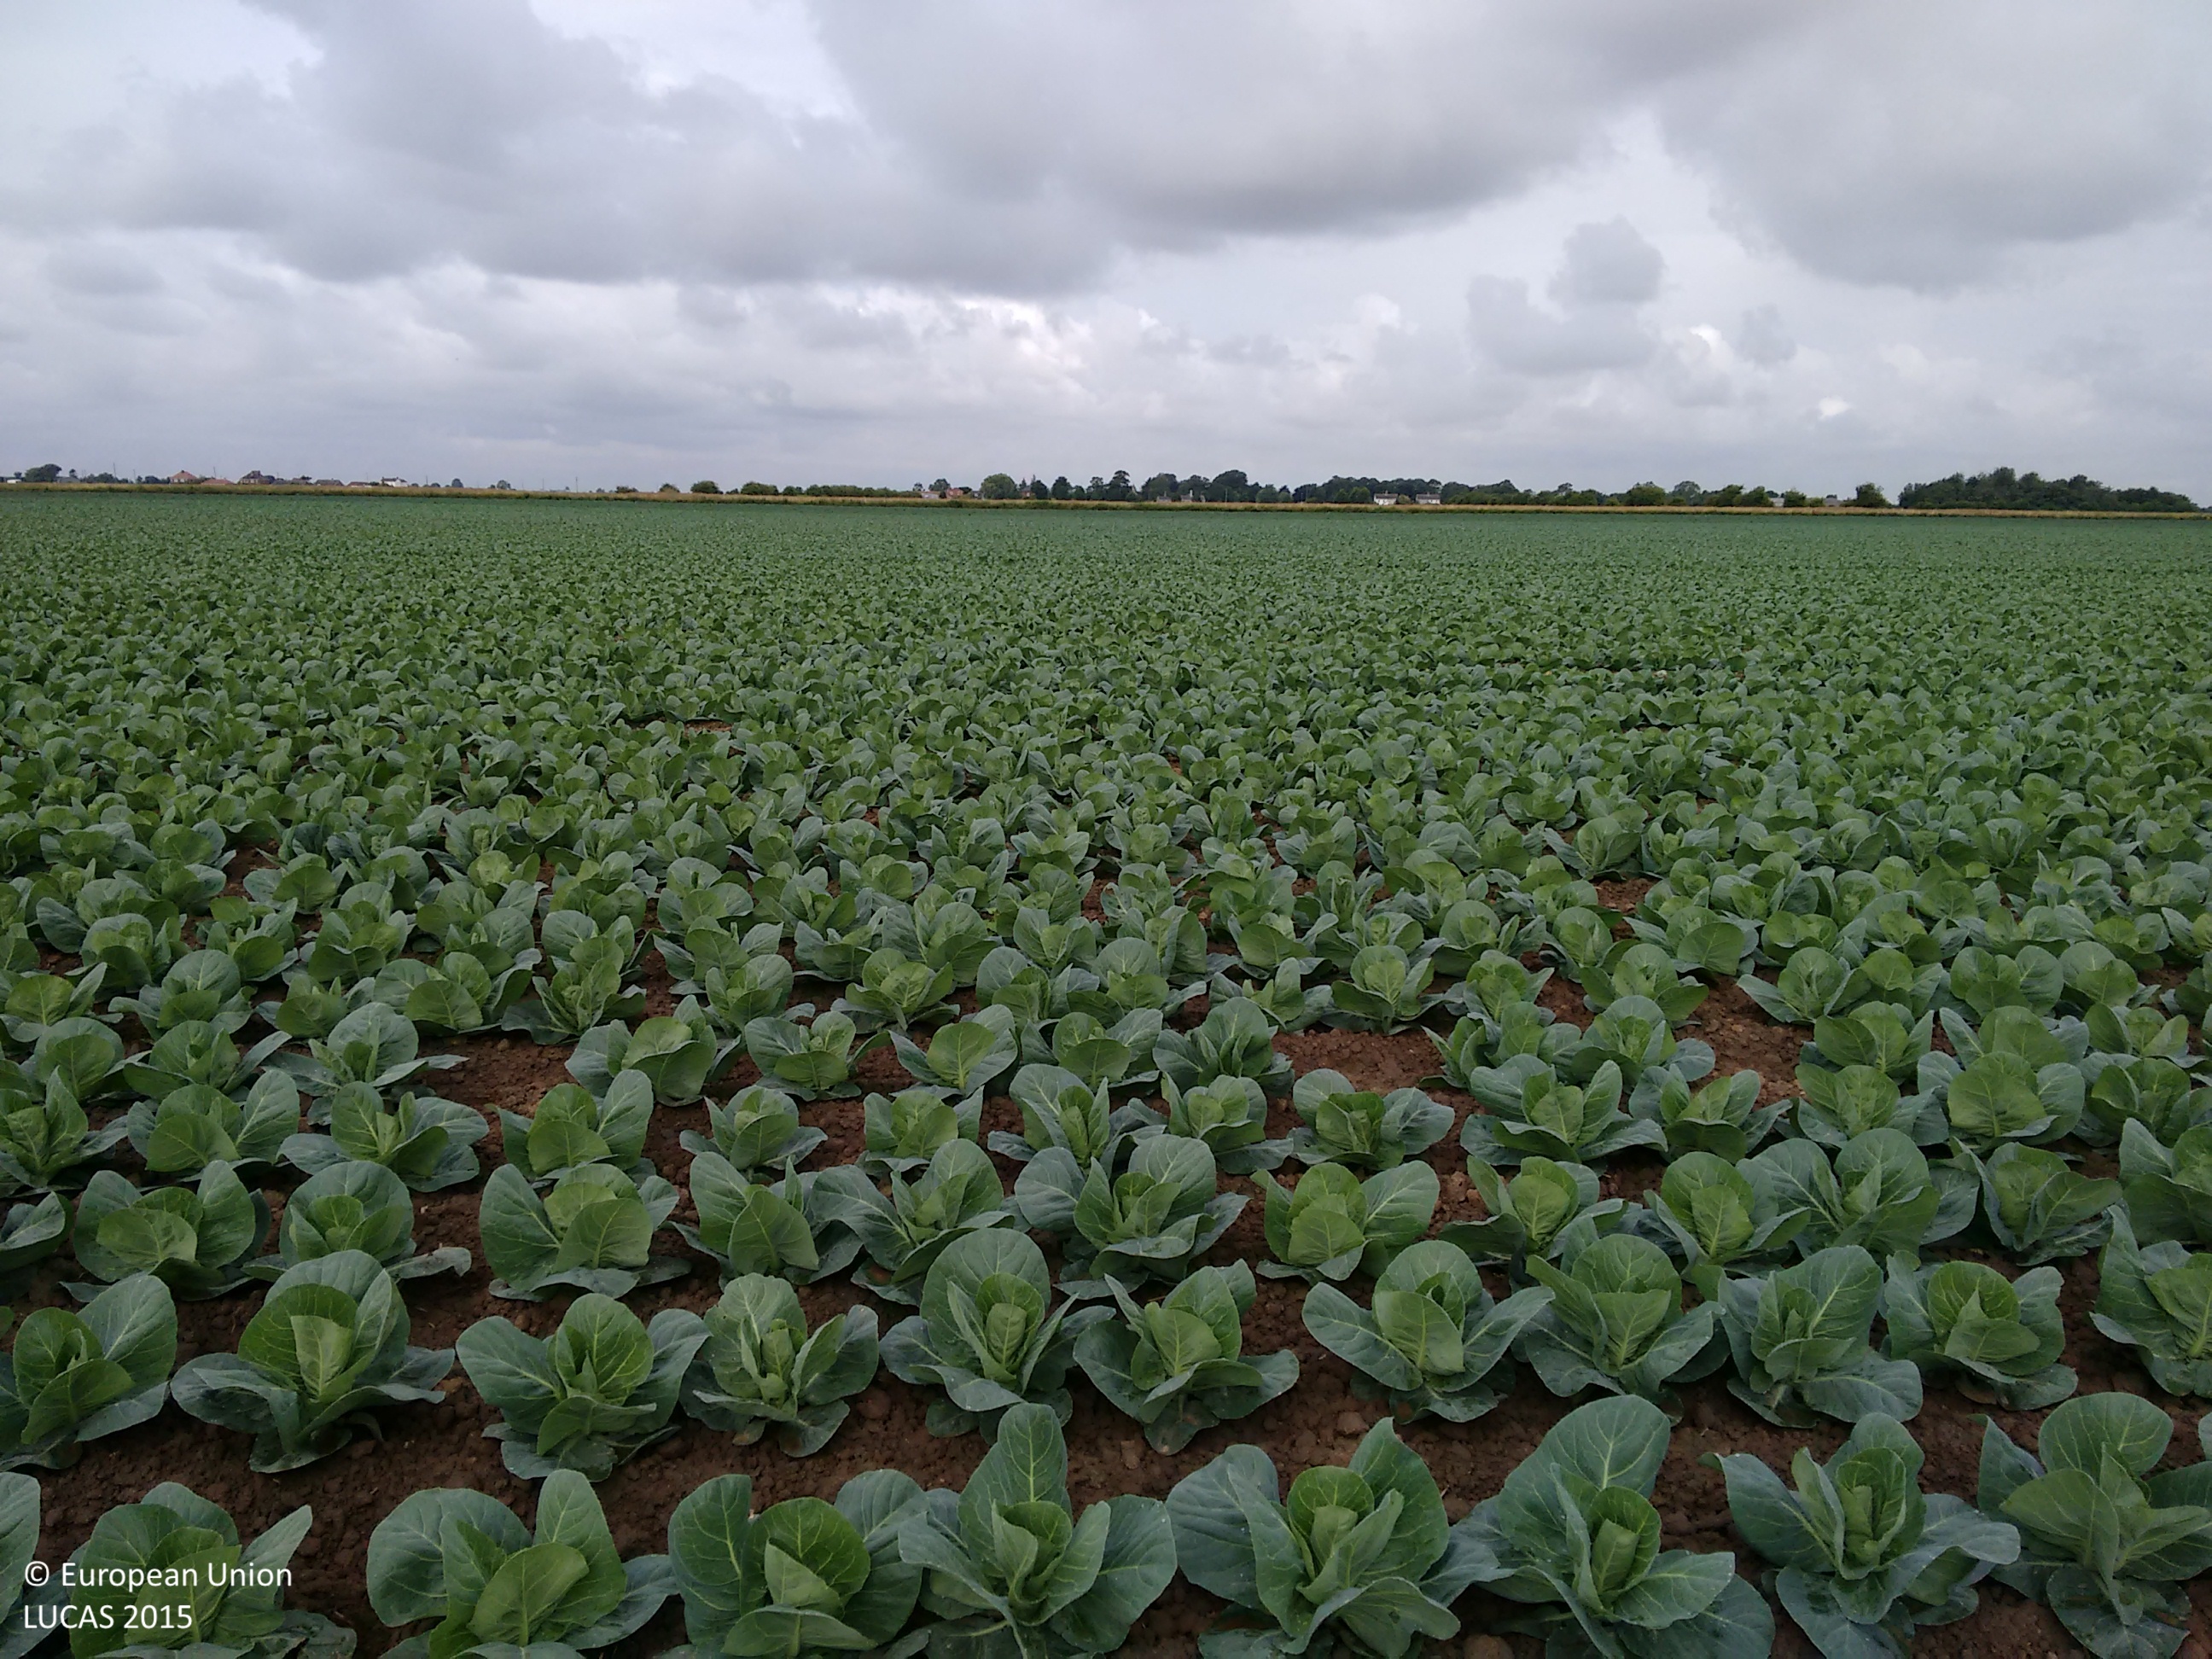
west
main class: Cropland
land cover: Other fresh vegetables
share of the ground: 50 - 75 %
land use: Agriculture (excluding fallow land and kitchen gardens)
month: July
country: GB
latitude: 52.9975
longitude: -0.0905
